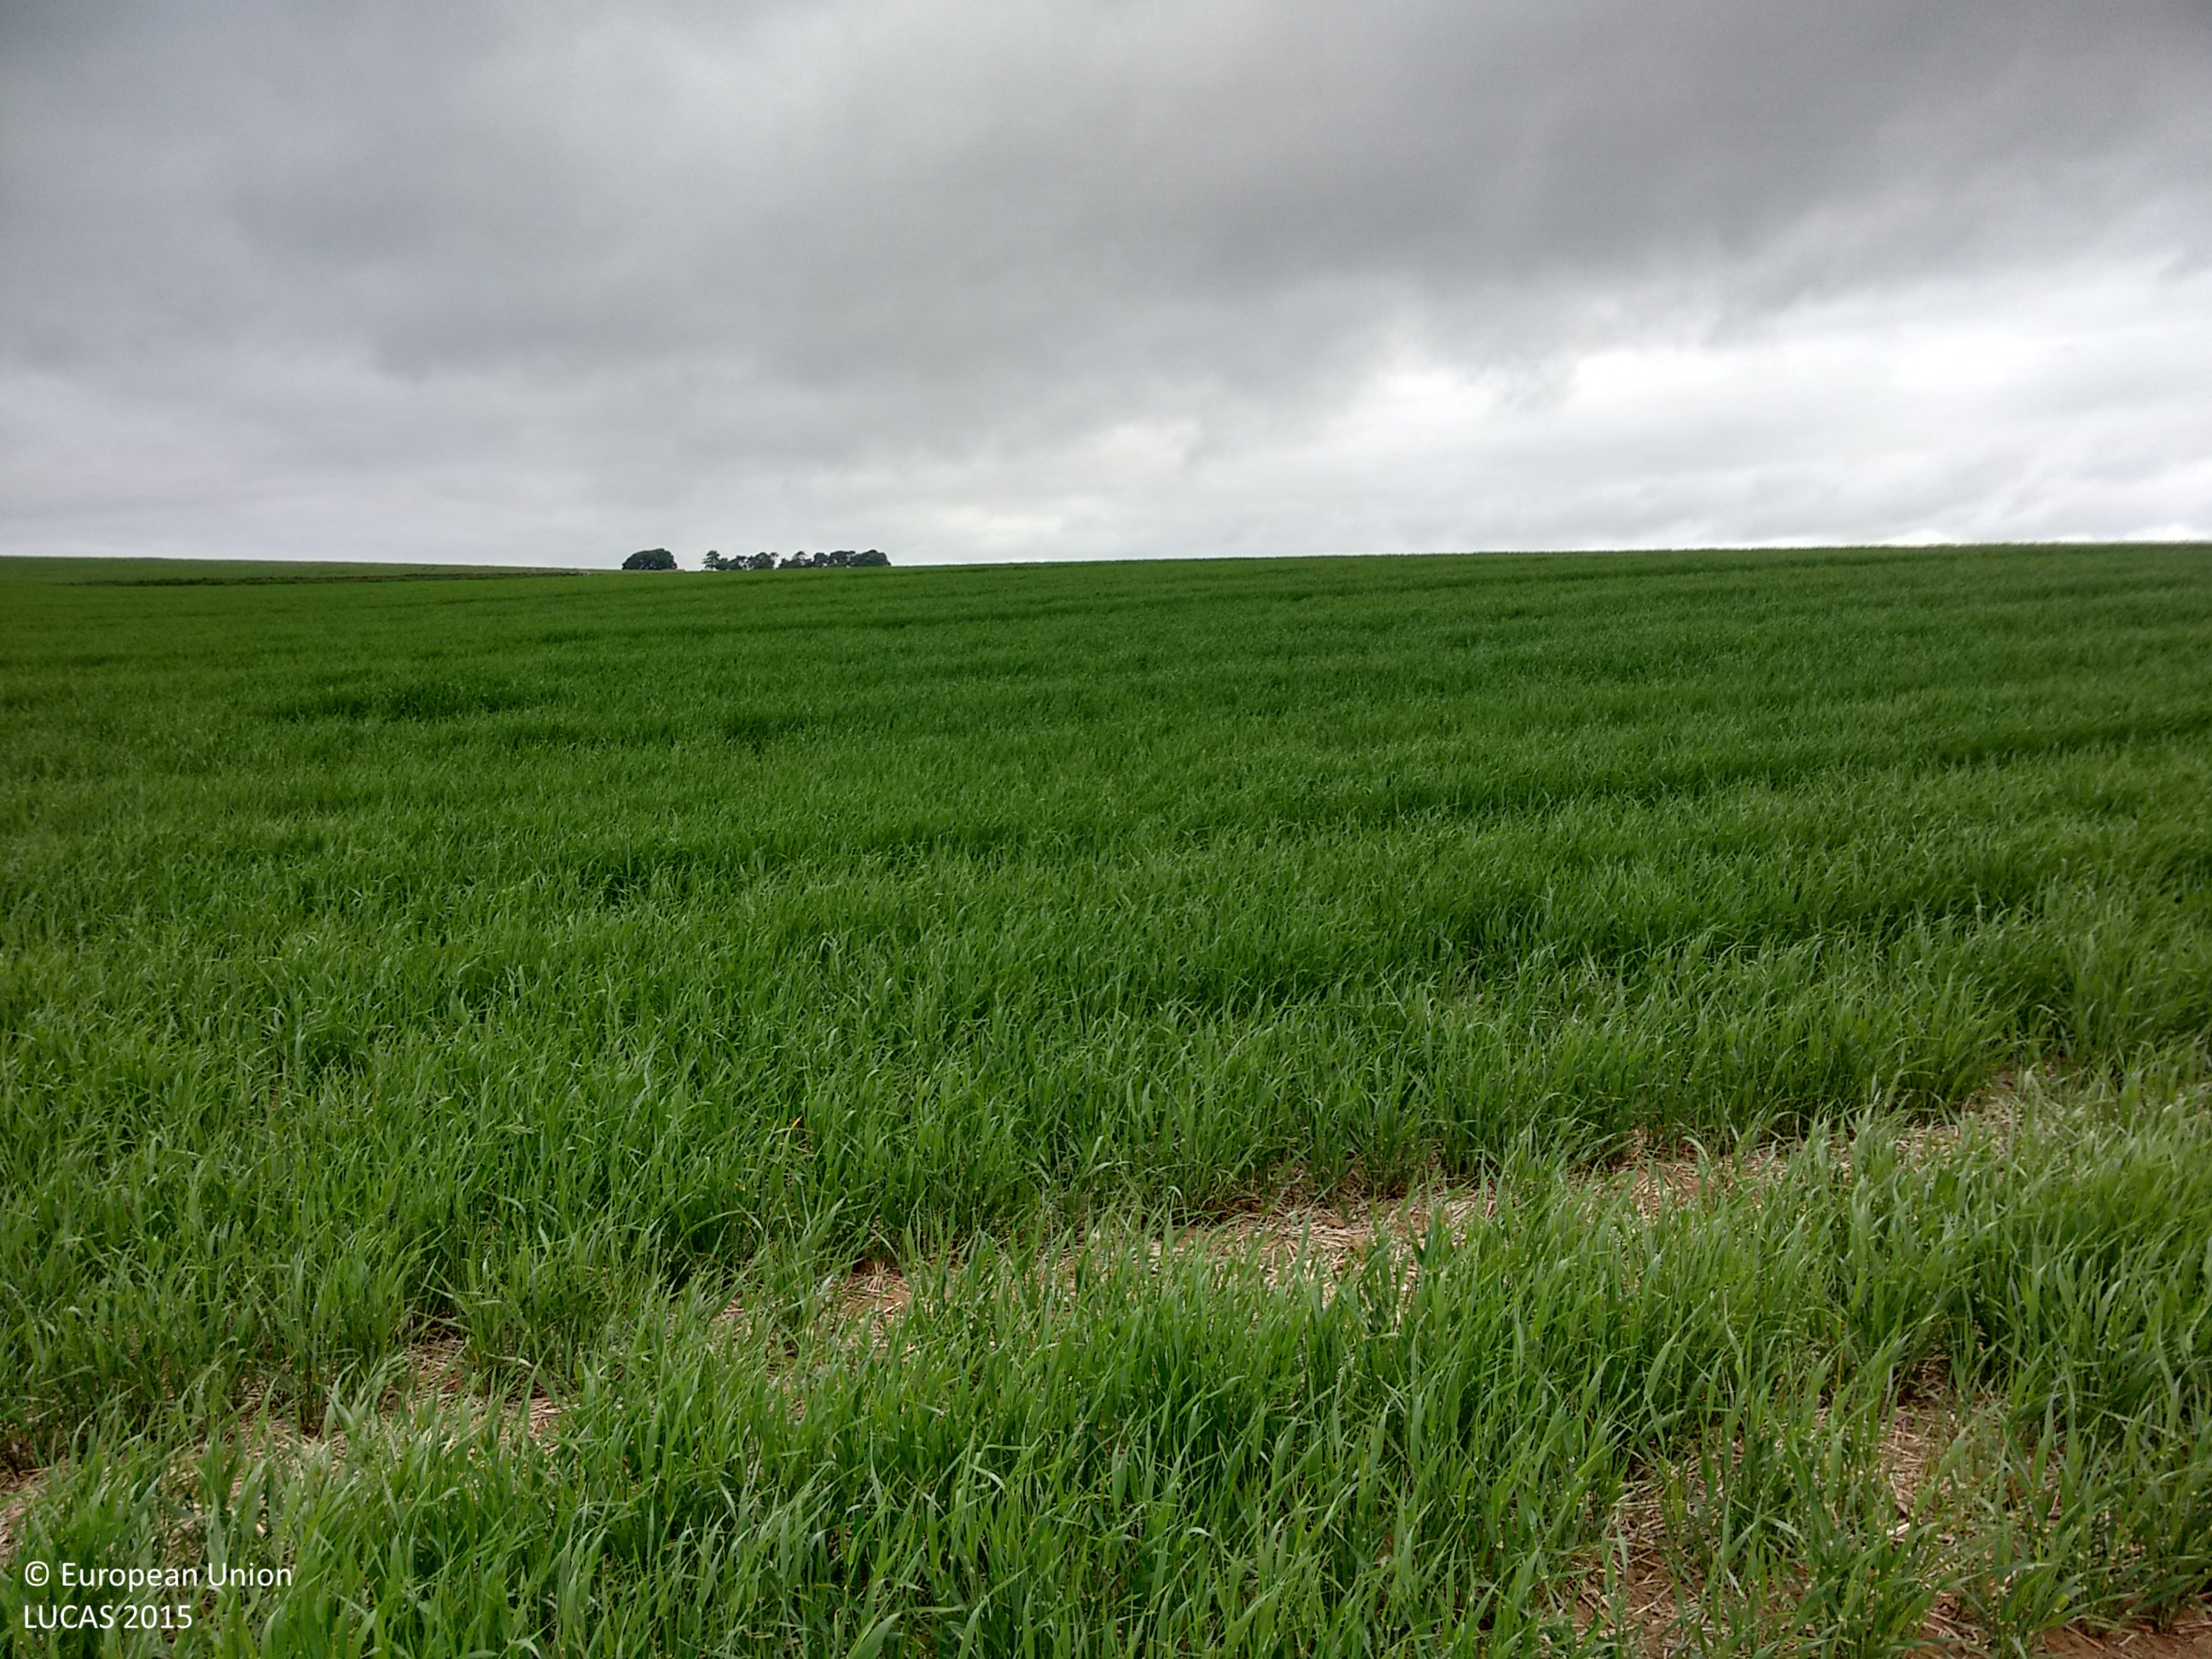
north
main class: Cropland
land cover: Barley
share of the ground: > 75 %
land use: Agriculture (excluding fallow land and kitchen gardens)
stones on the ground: < 10 %
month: June
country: GB
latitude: 54.2779
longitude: -1.2103
